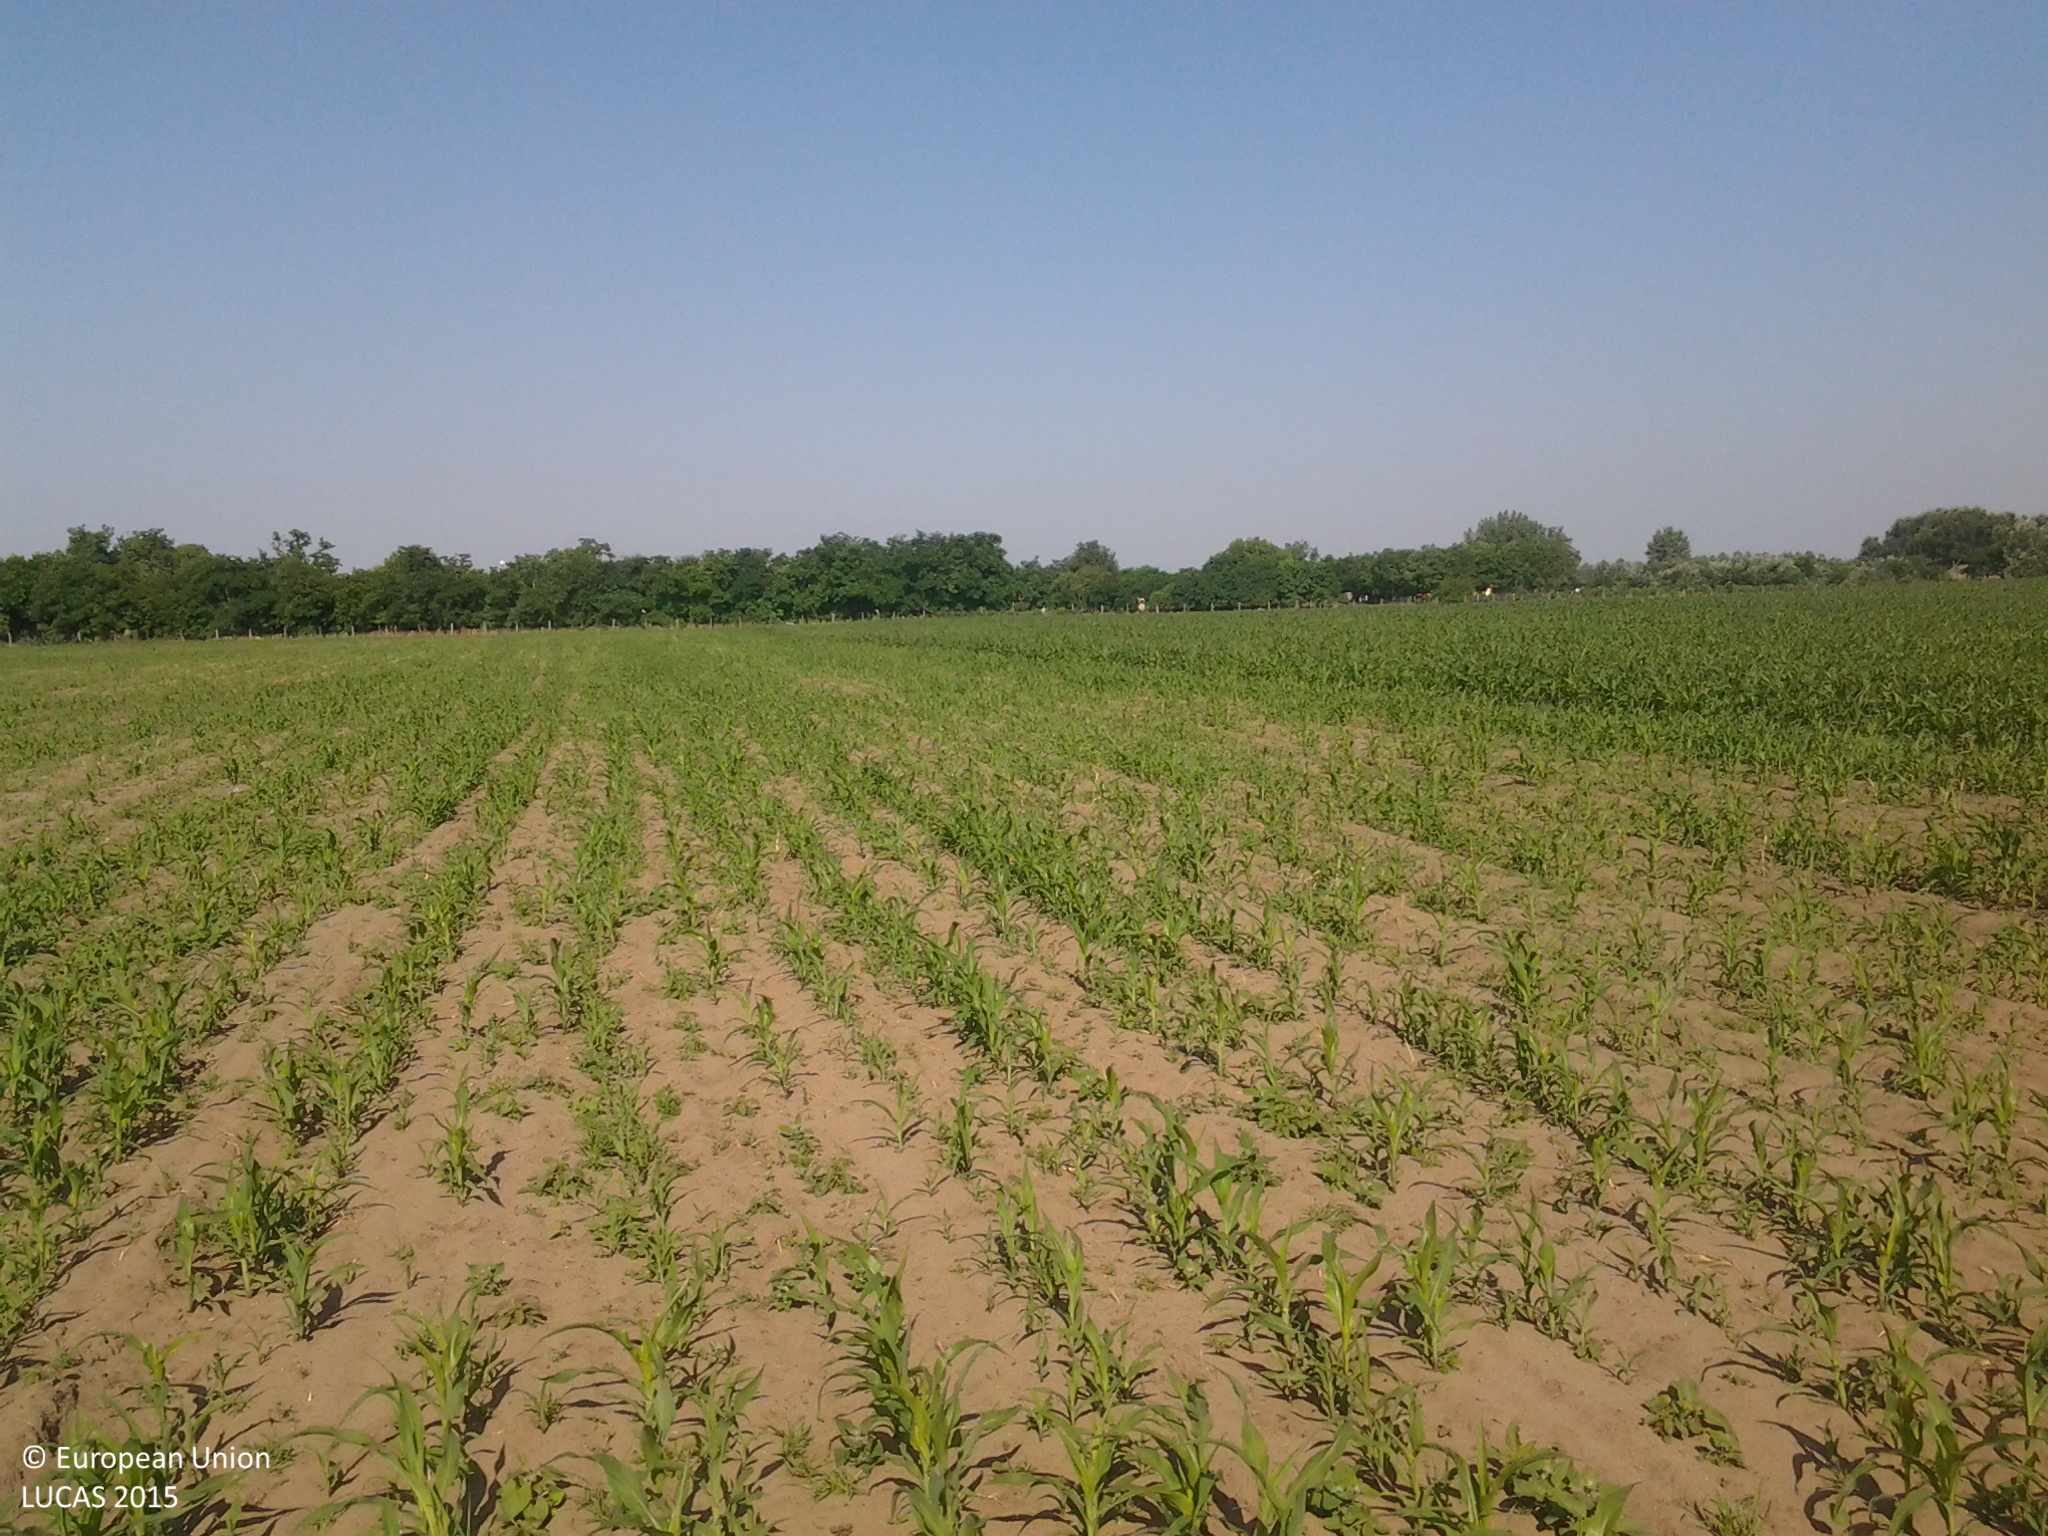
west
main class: Cropland
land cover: Maize
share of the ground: 50 - 75 %
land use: Agriculture (excluding fallow land and kitchen gardens)
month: July
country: HU
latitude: 46.6310
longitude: 19.5402
